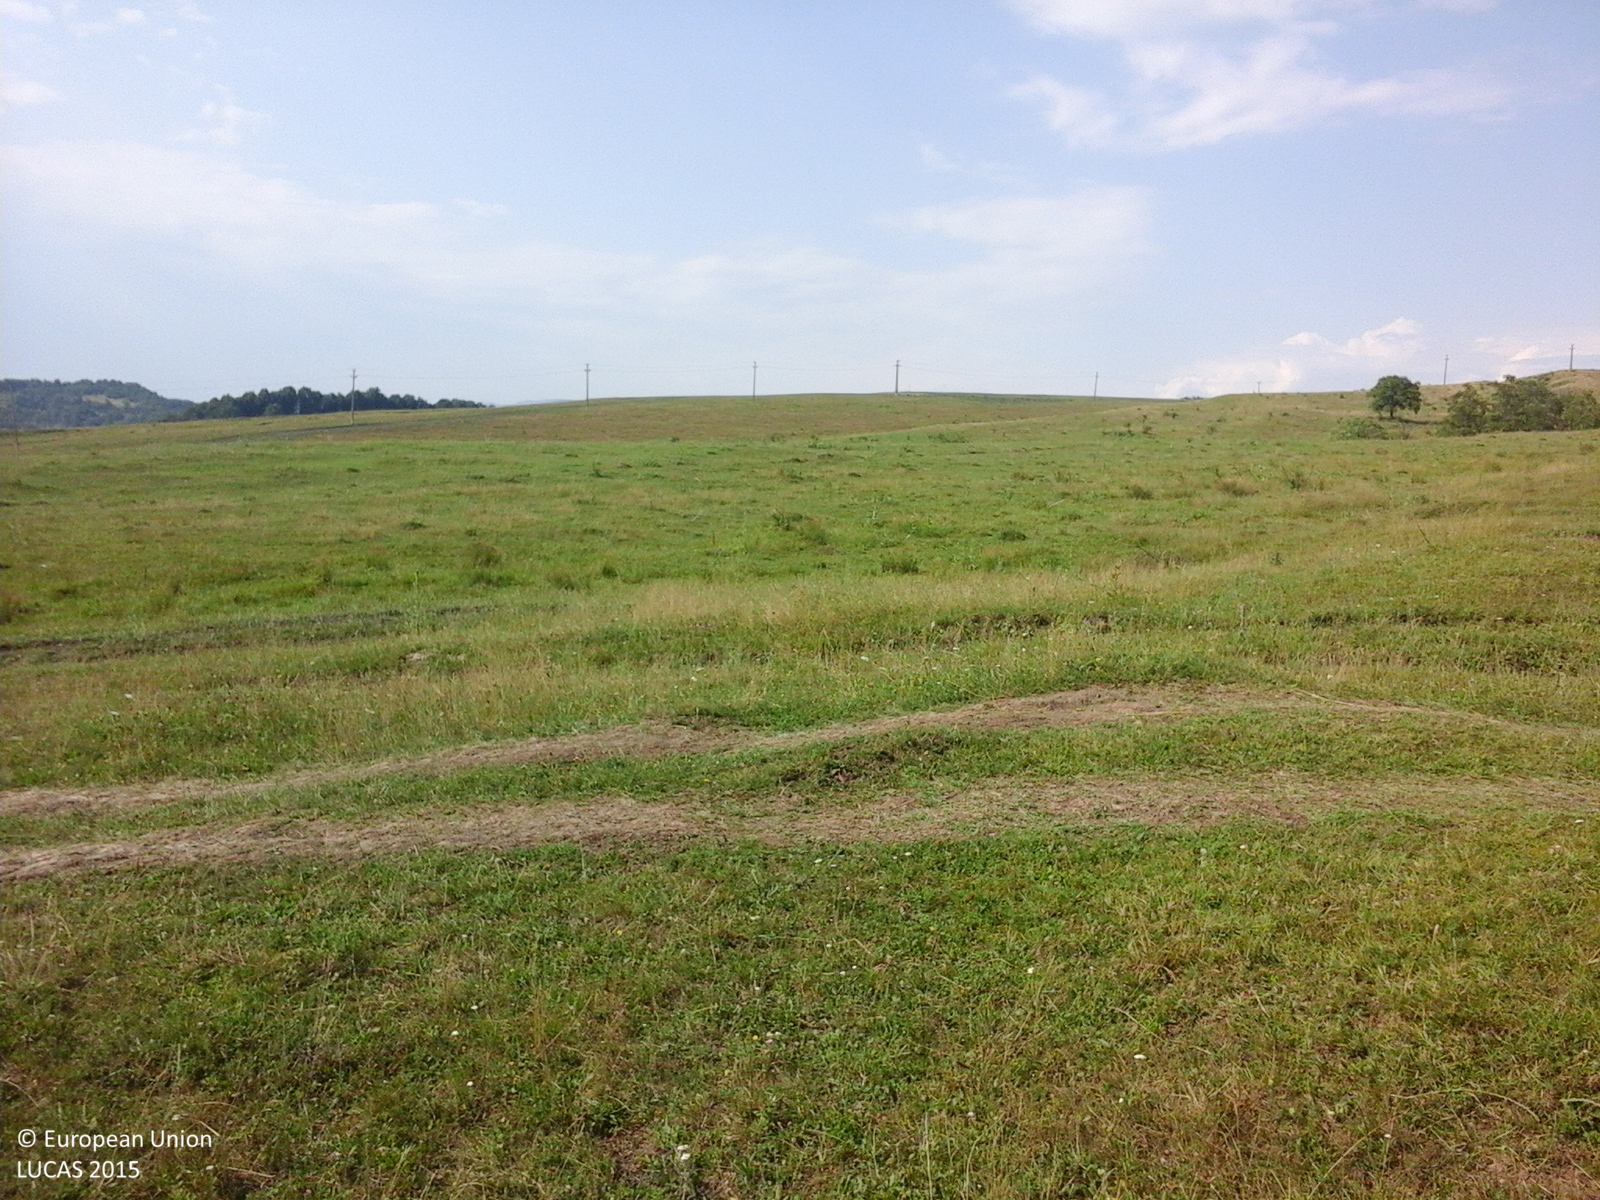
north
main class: Grassland
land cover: Grassland without tree/shrub cover
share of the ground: > 75 %
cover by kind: herbaceous plants 100 %
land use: Agriculture (excluding fallow land and kitchen gardens)
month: July
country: RO
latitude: 45.1783
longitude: 24.7284
